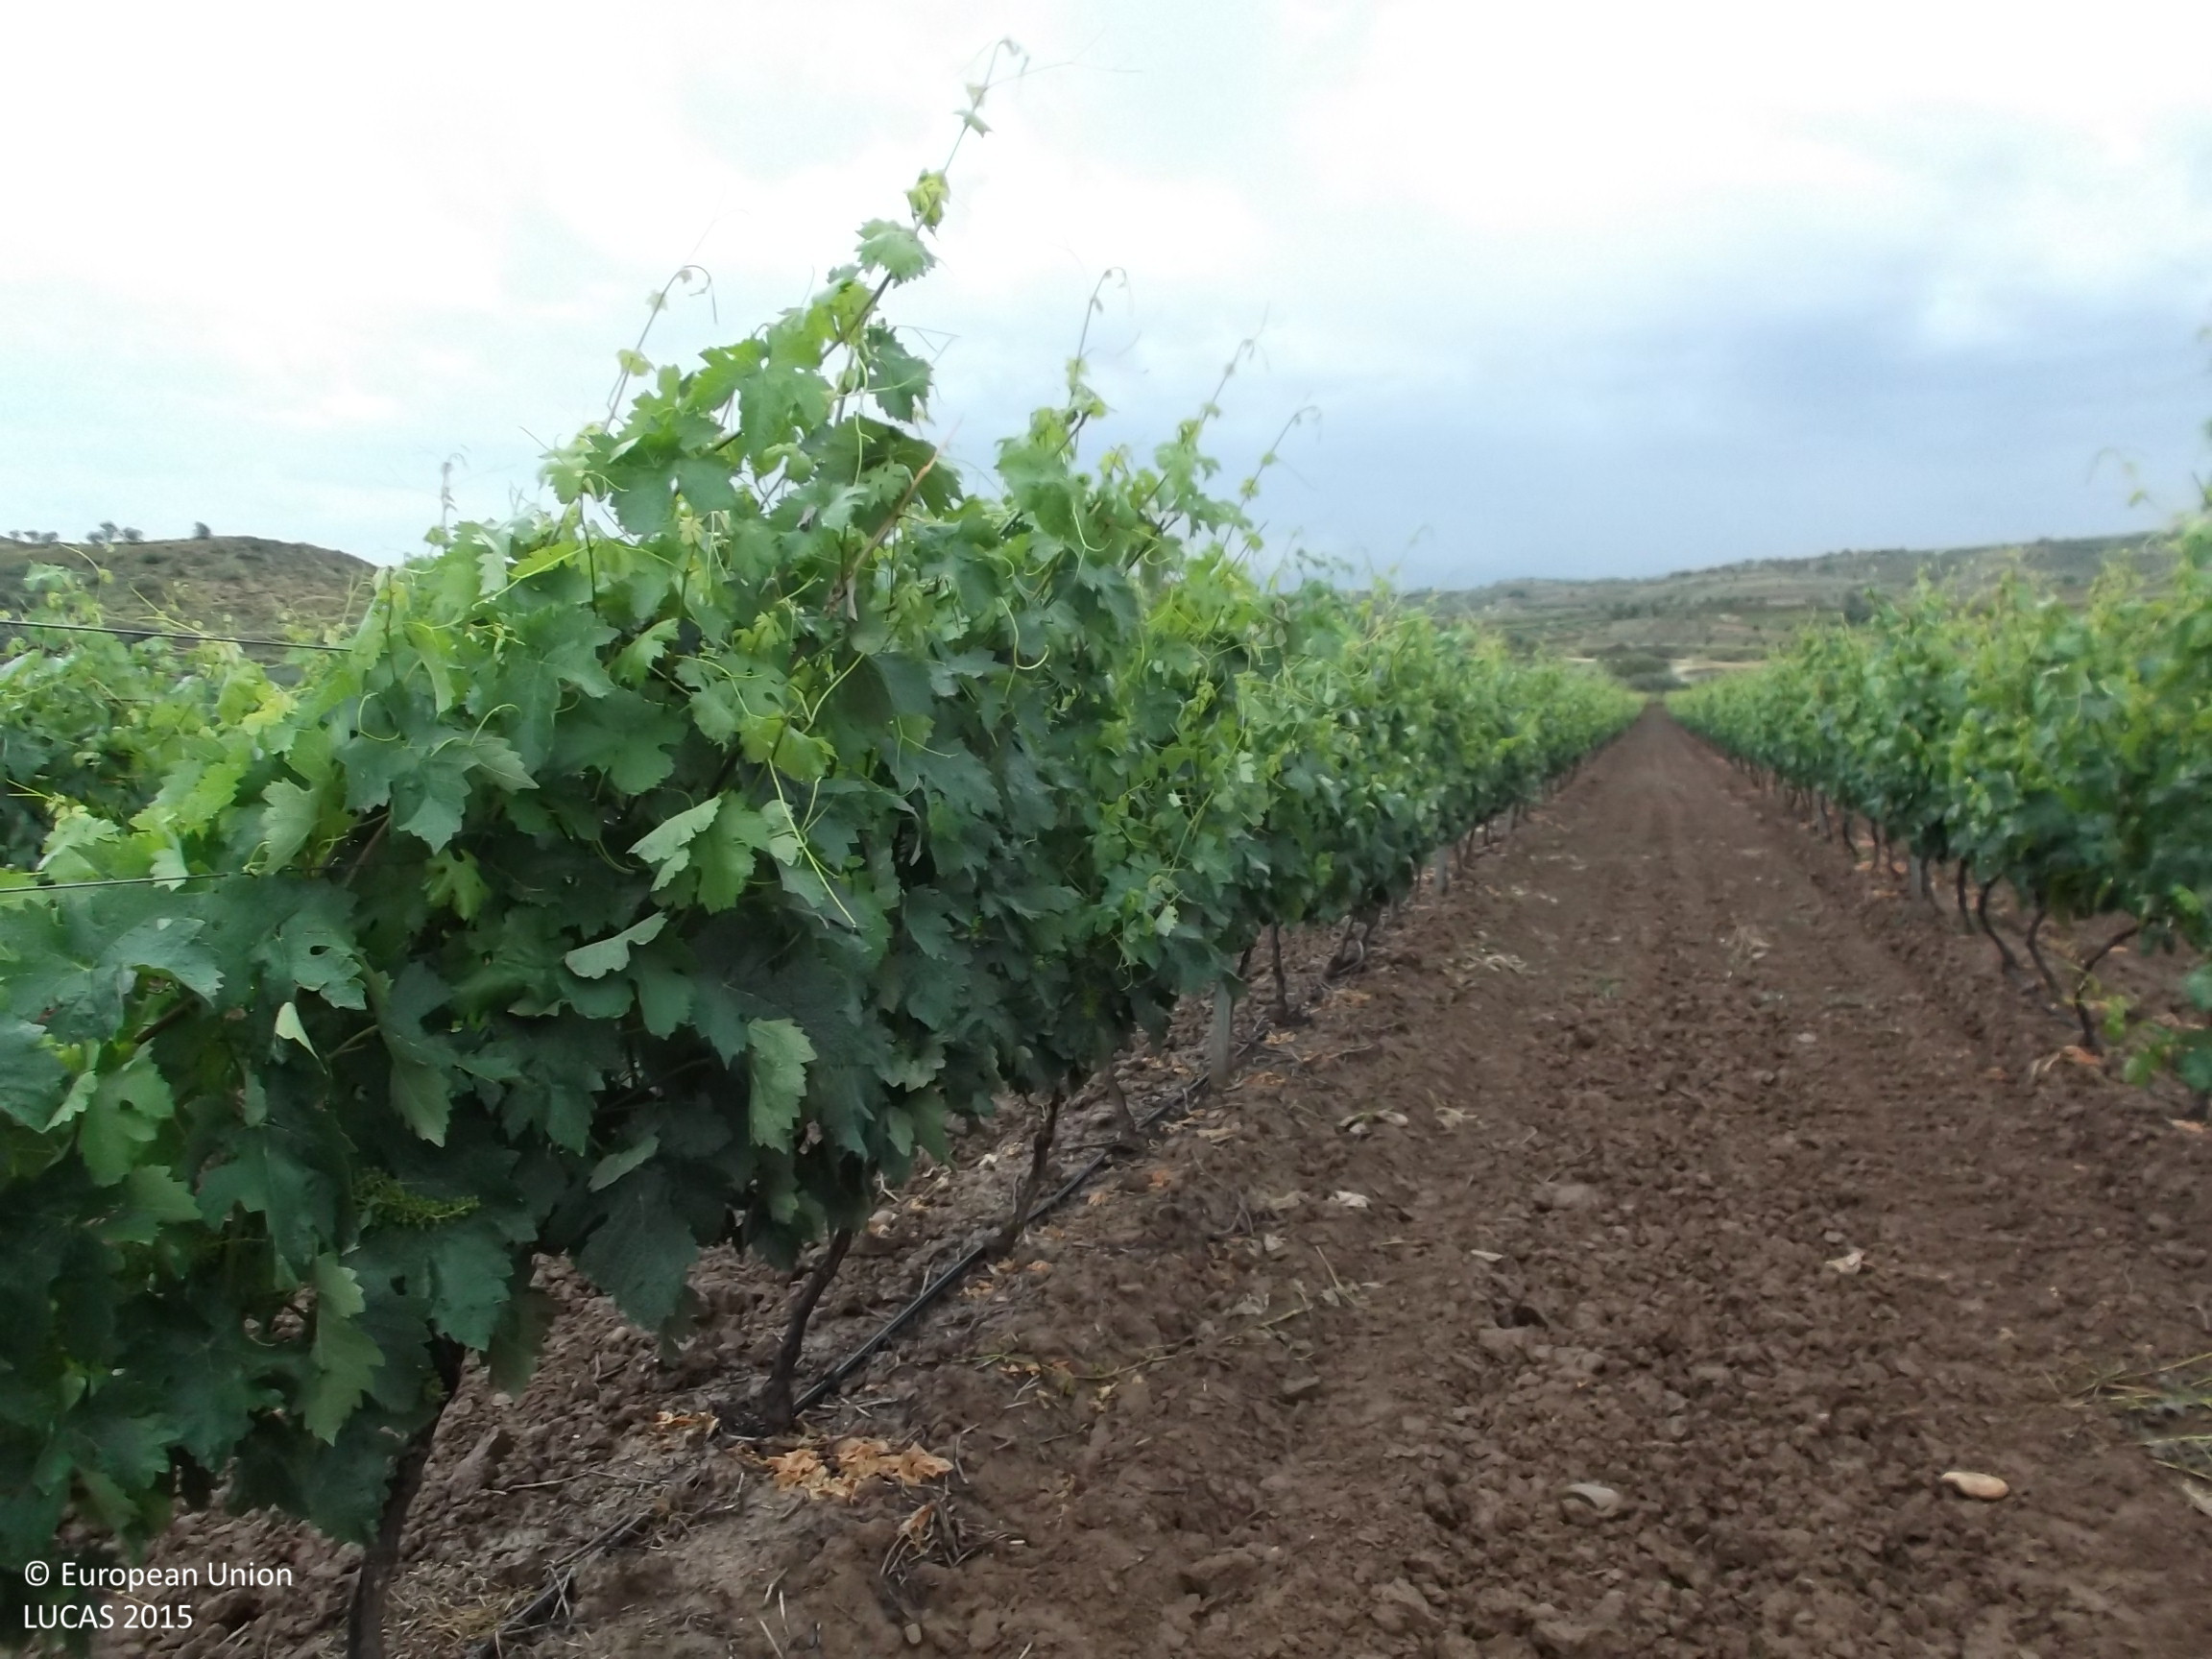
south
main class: Cropland
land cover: Vineyards
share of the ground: 10 - 25 %
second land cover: Other bare soil
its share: > 75 %
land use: Agriculture (excluding fallow land and kitchen gardens)
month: June
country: ES
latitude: 42.3966
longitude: -2.1282
